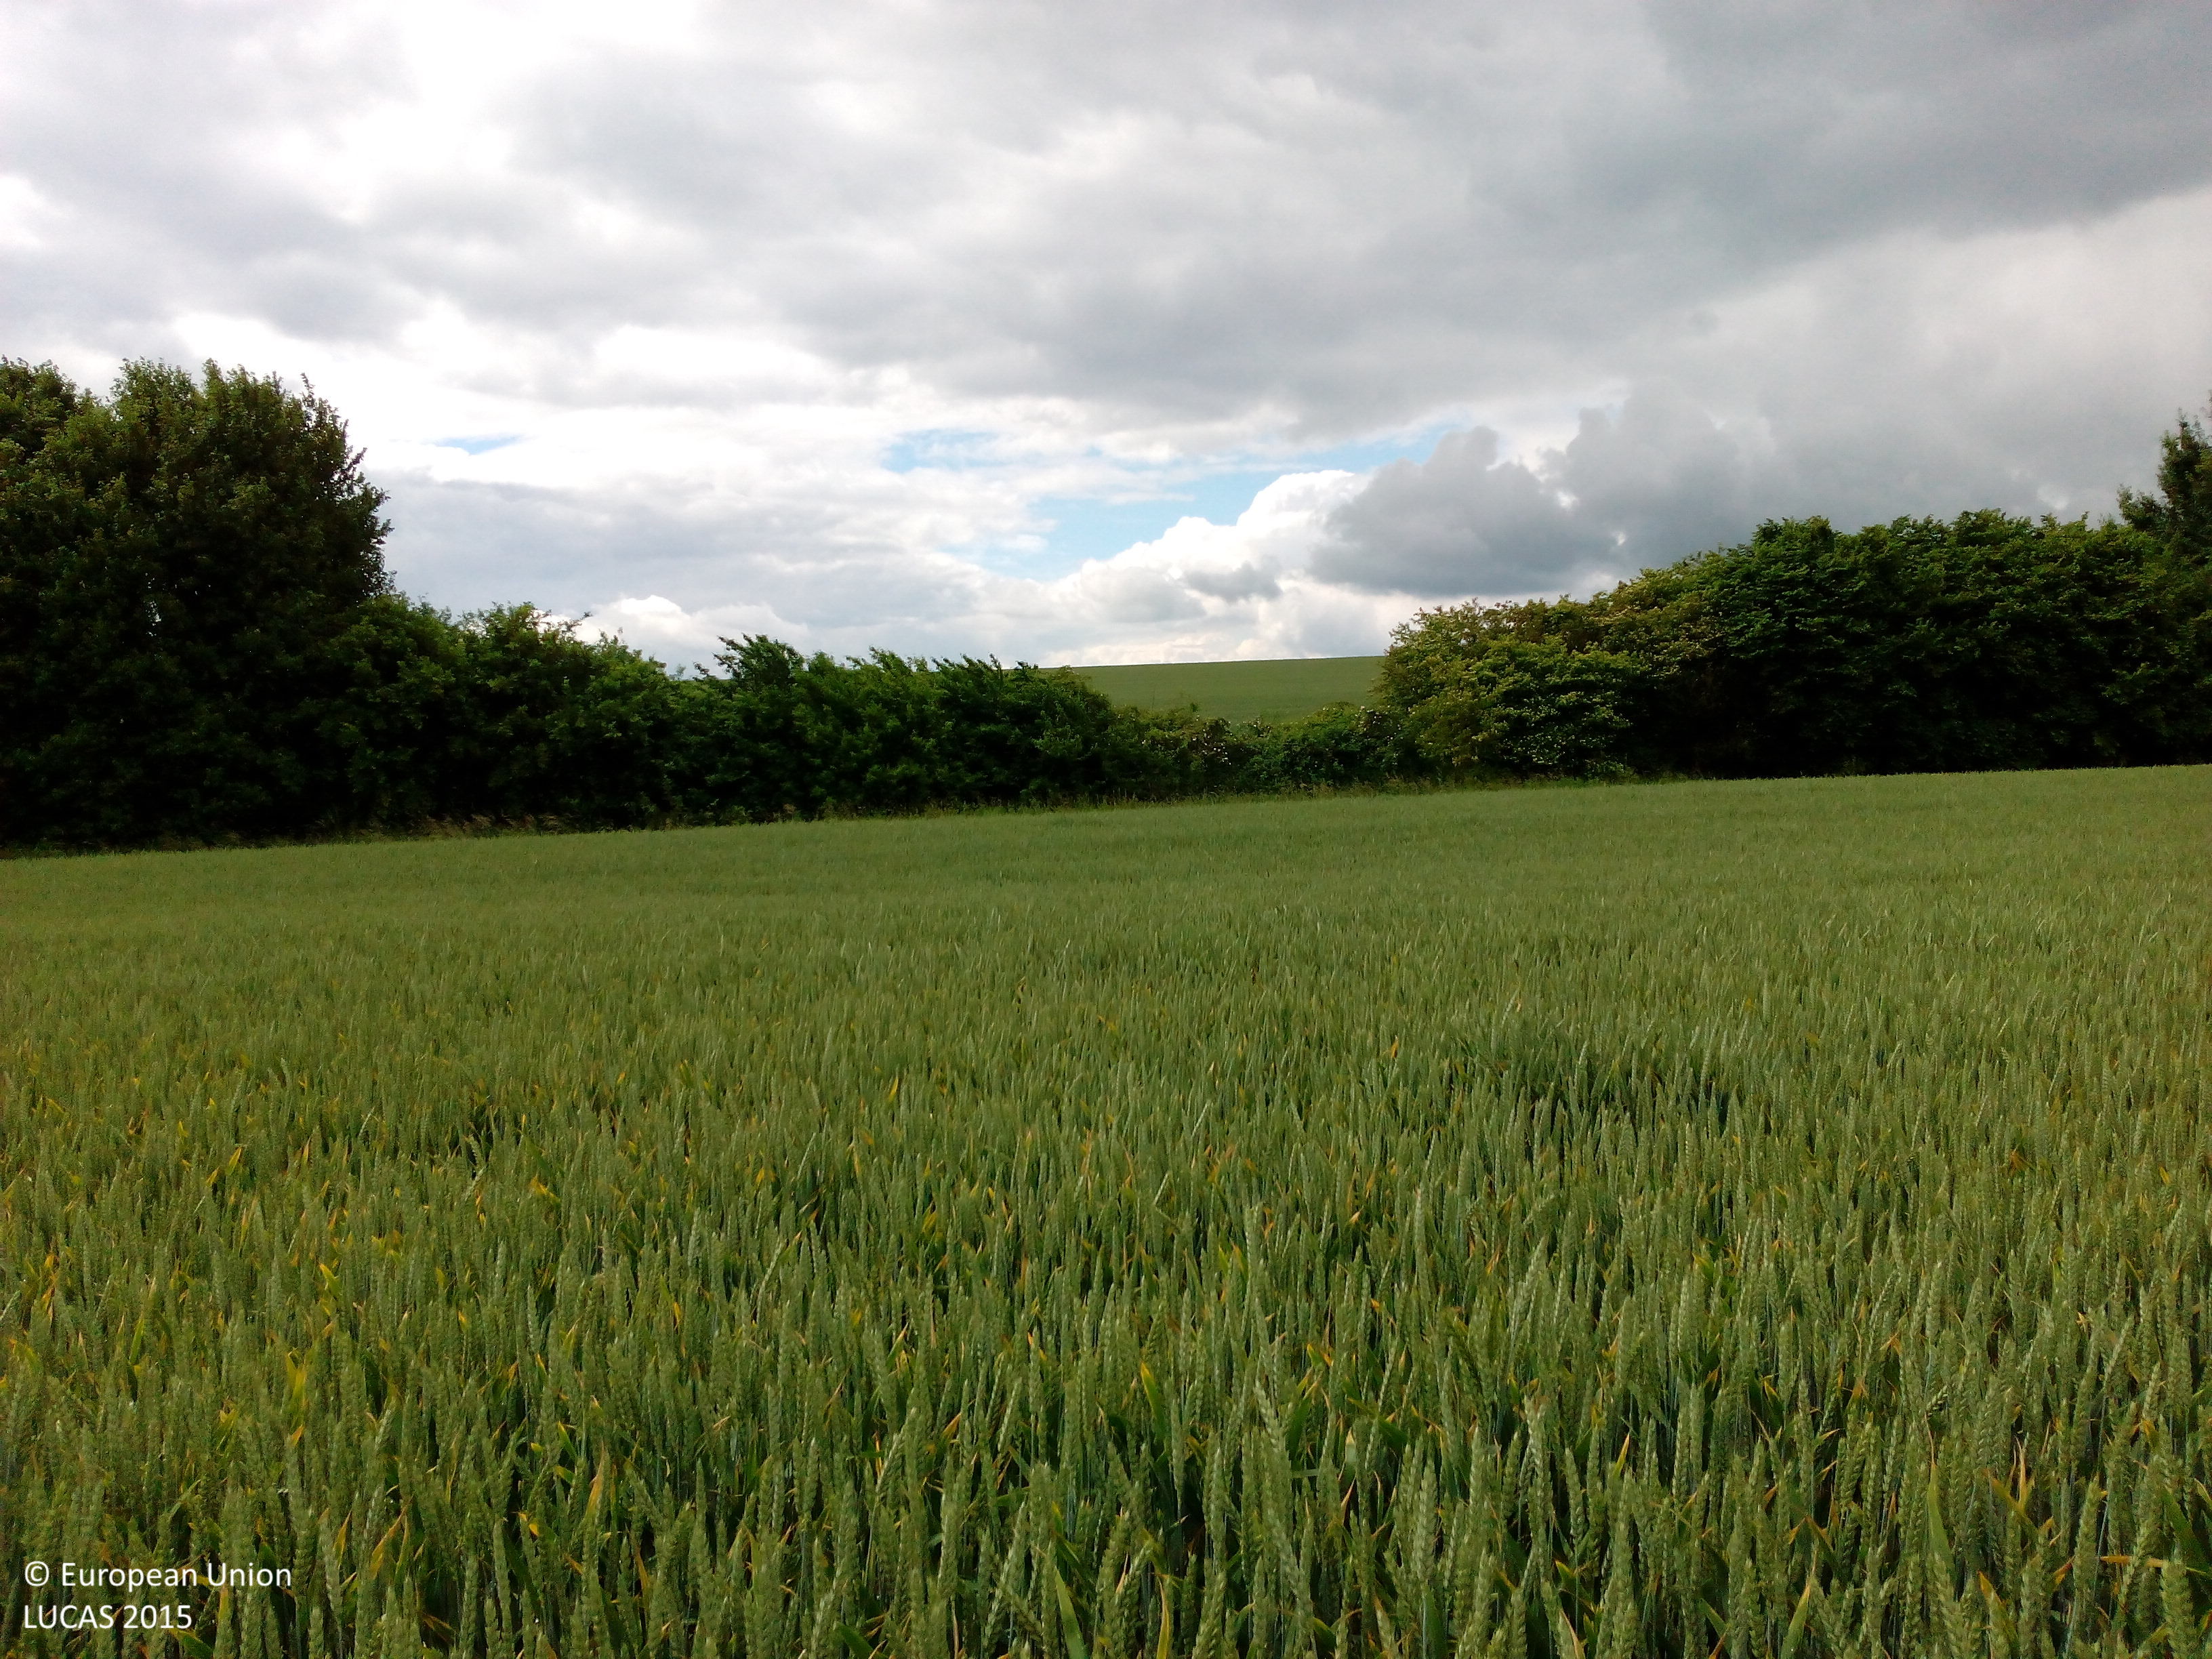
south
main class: Cropland
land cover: Common wheat
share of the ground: > 75 %
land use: Agriculture (excluding fallow land and kitchen gardens)
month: June
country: DE
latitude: 51.8741
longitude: 9.8403
